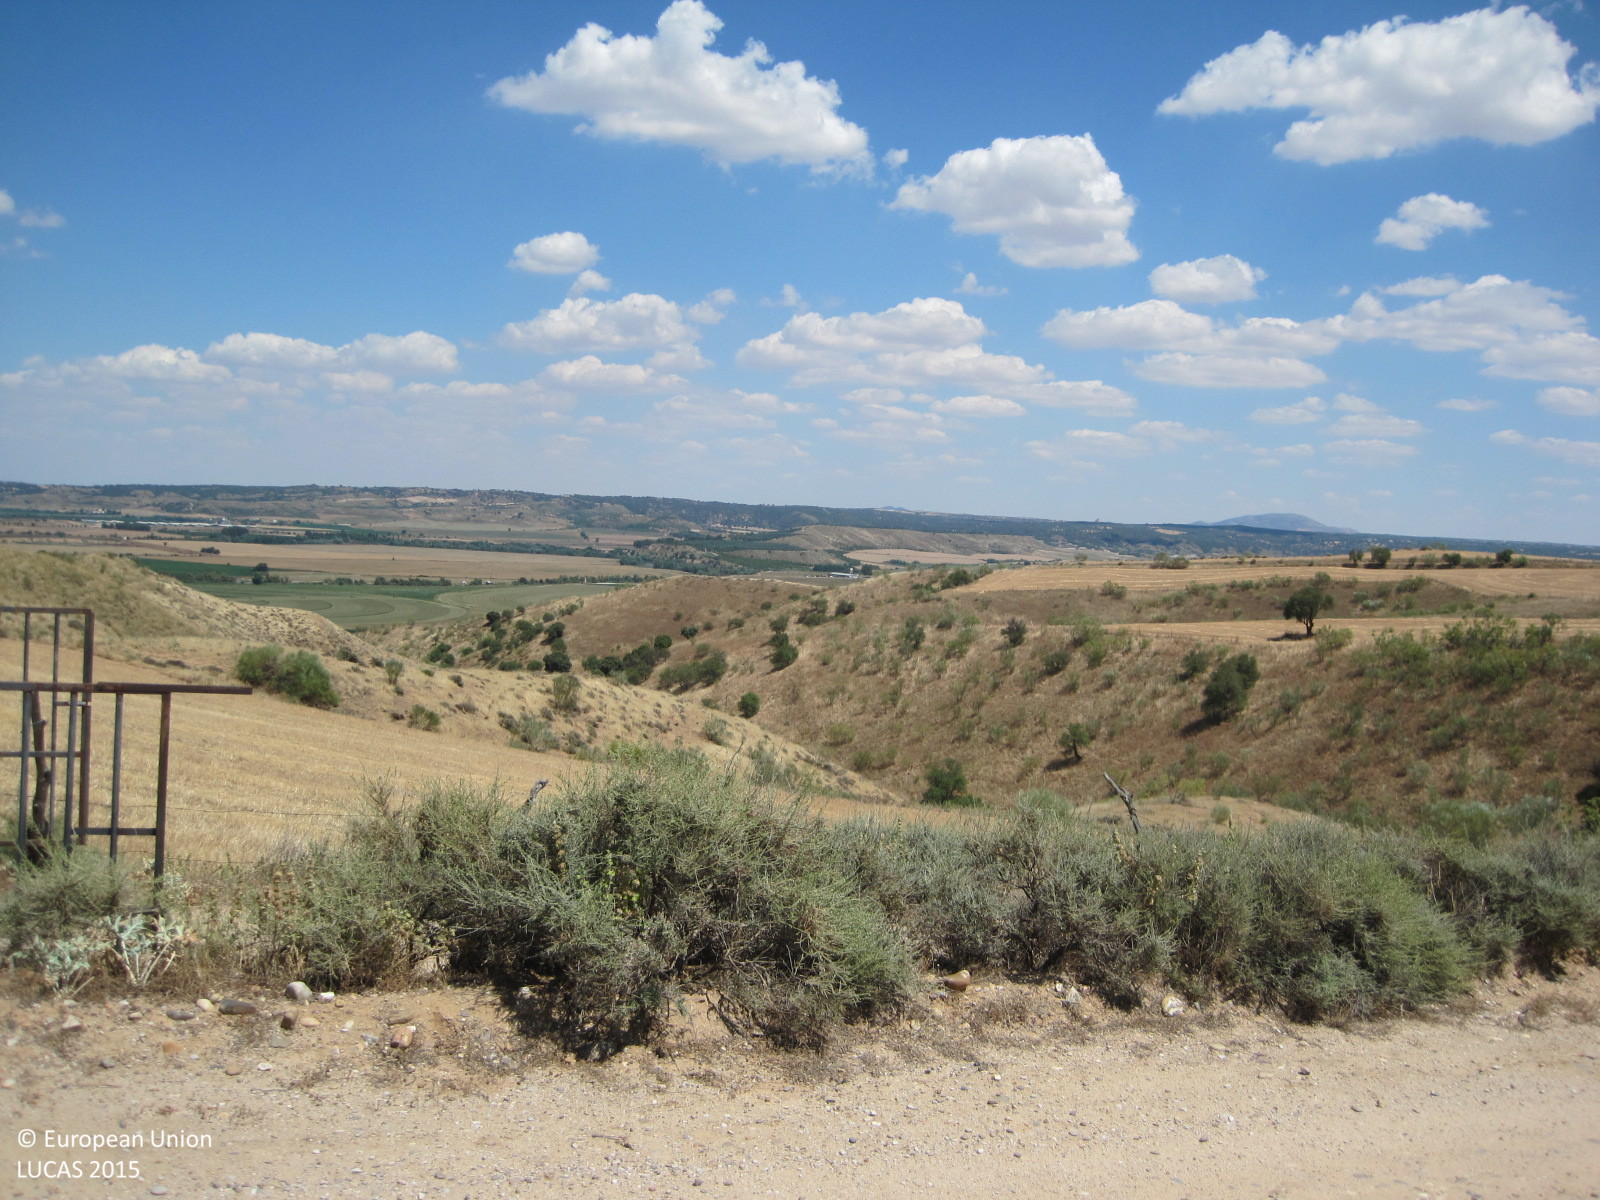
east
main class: Shrubland
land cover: Shrubland without tree cover
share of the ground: > 75 %
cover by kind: shrubs 100 %
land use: Semi-natural and natural areas not in use
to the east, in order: Shrubland without tree cover; Fences; Shruby margins; Tracks; Shruby margins; Fences; Grass margins; Oats
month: June
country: ES
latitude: 39.8611
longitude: -4.2640
